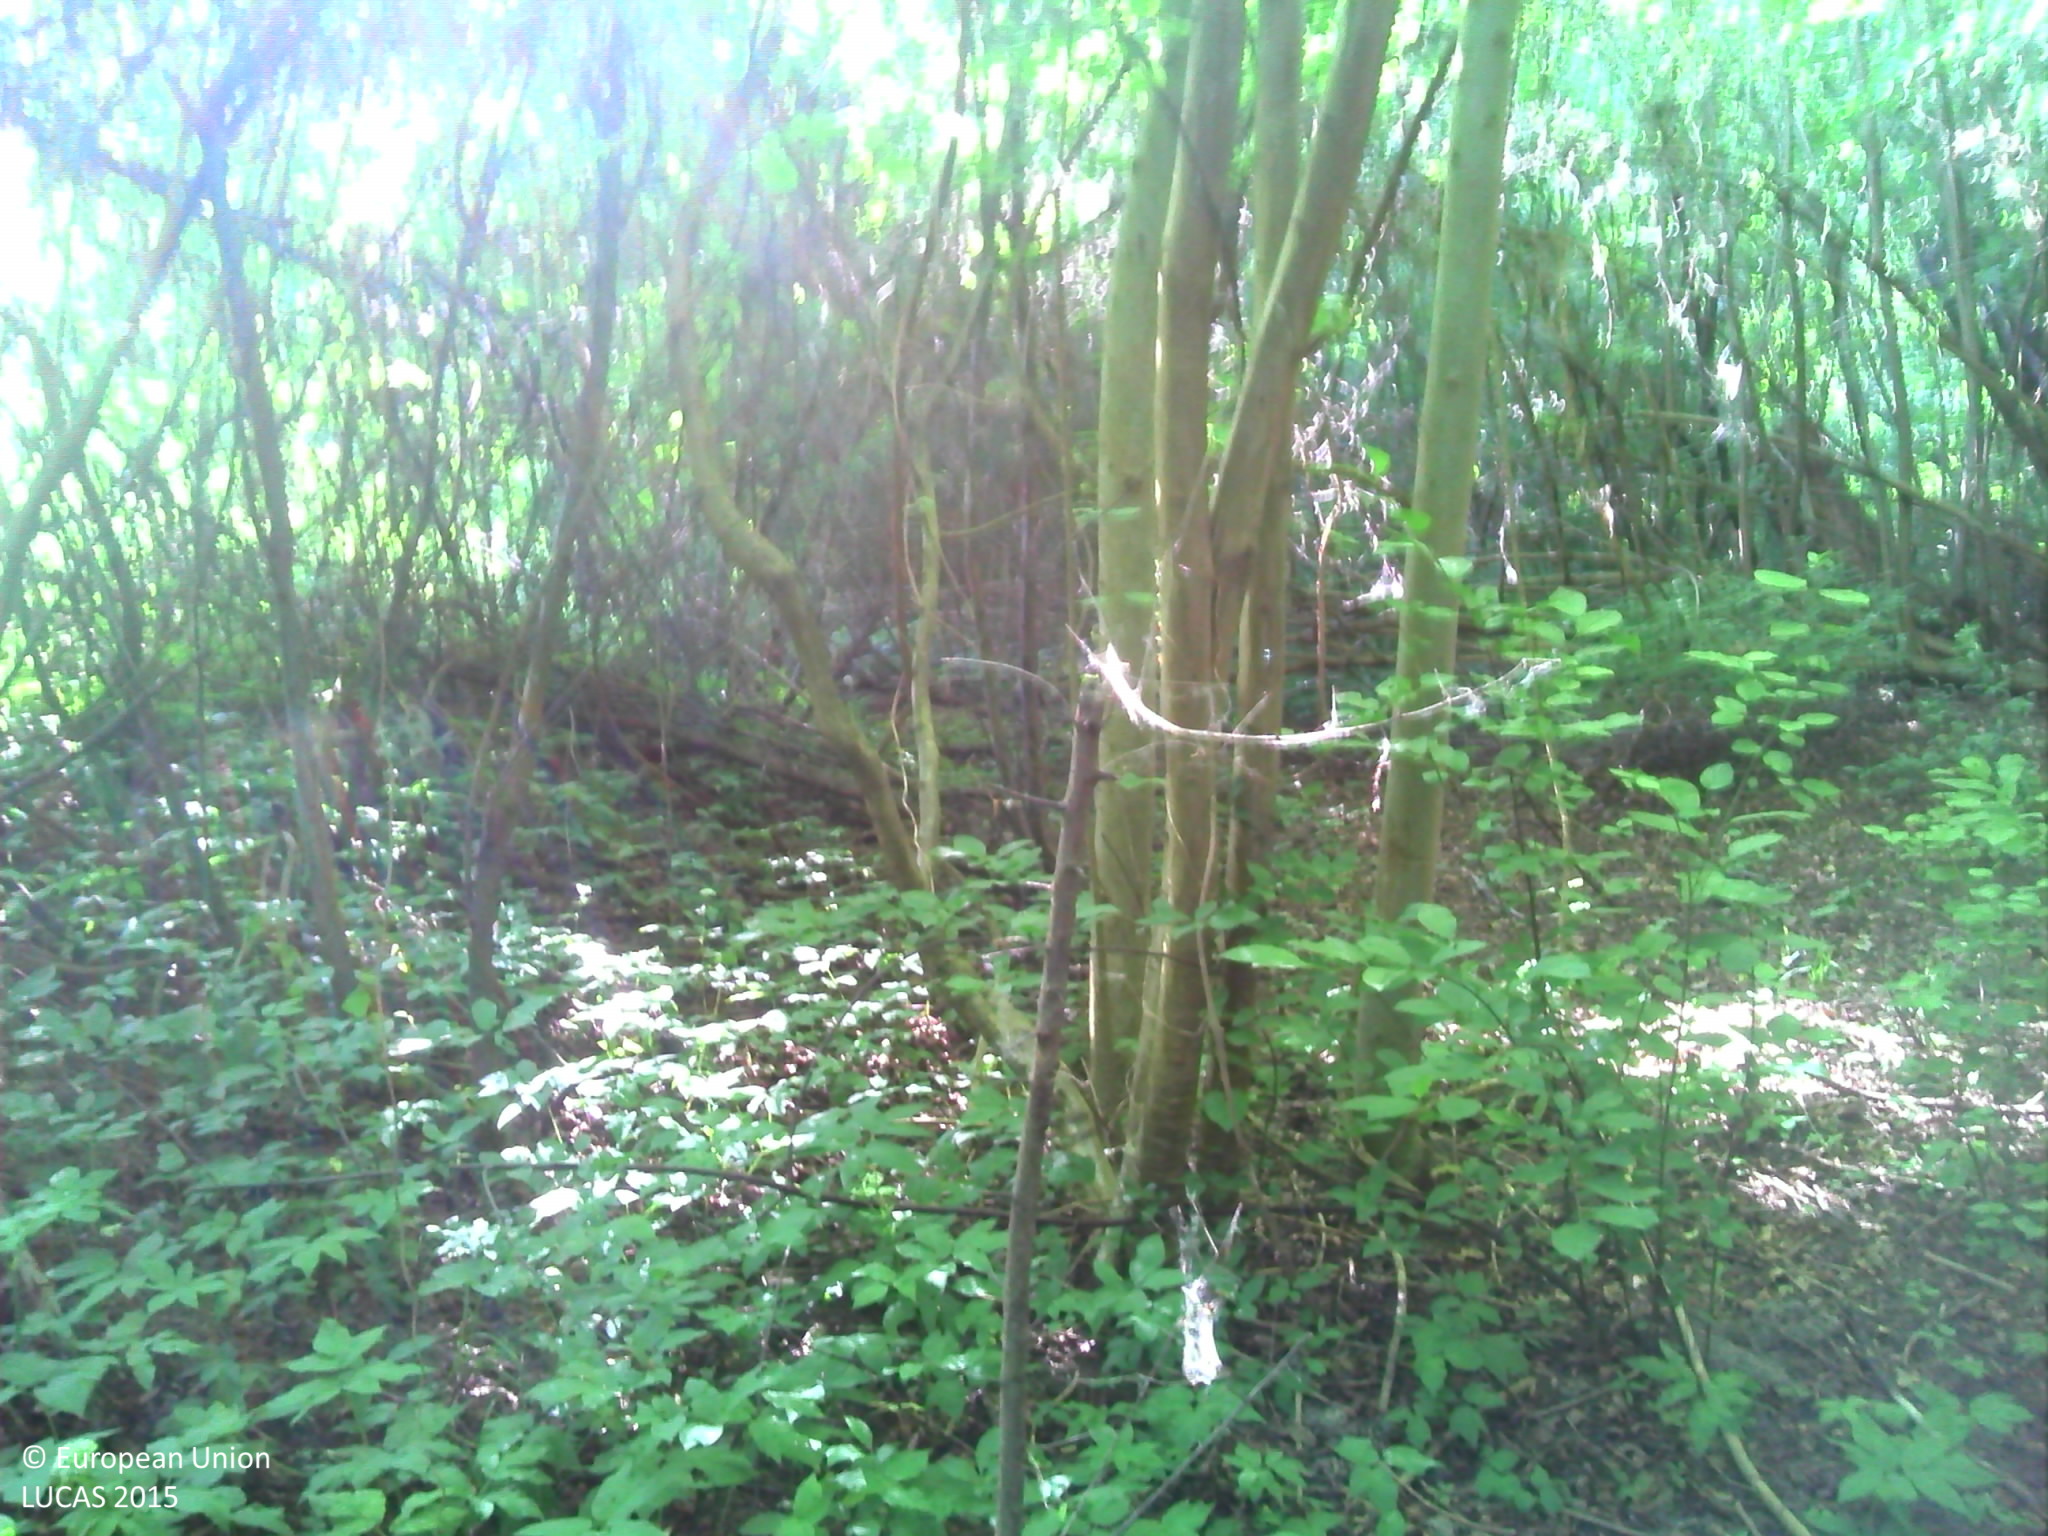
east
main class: Woodland
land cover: Broadleaved woodland
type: mesophytic deciduous forest
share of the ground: > 75 %
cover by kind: broadleaved forest trees 95 %, herbaceous plants 5 %
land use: Forestry
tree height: > 5 m
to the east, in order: Broadleaved woodland; Sugar beet; Broadleaved woodland
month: June
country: FR
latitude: 48.3620
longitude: 7.7199
